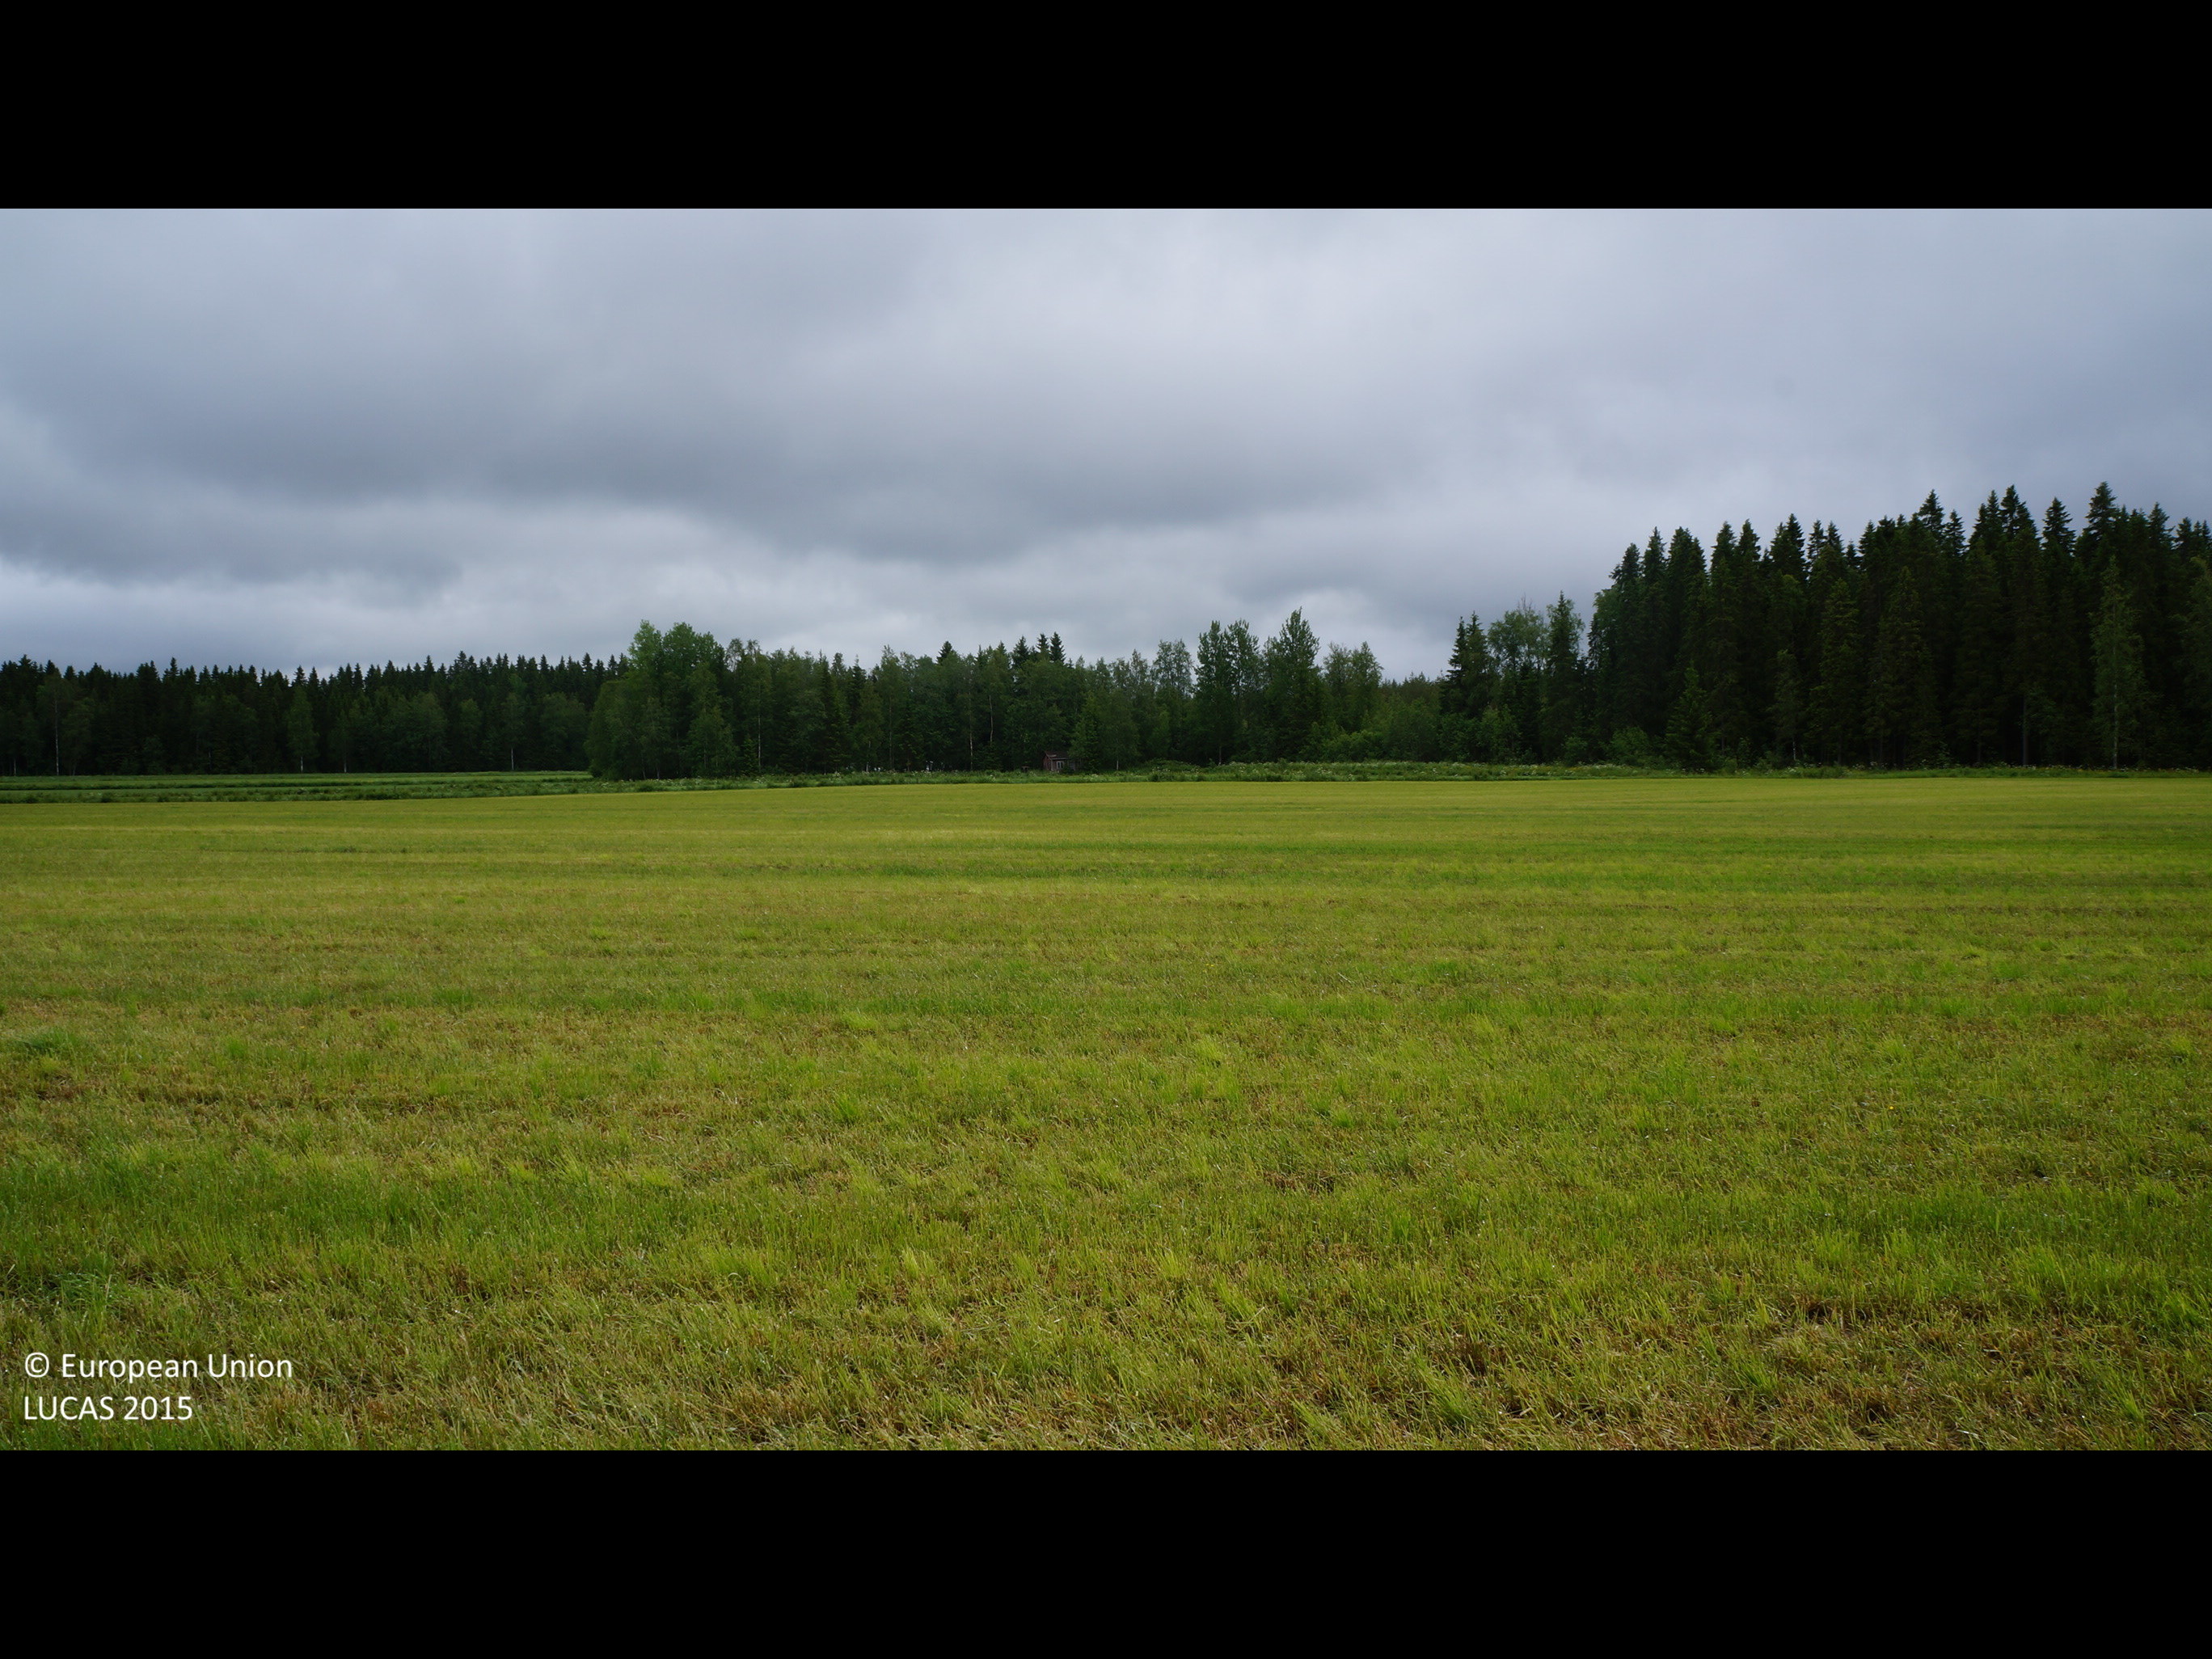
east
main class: Cropland
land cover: Temporary grasslands
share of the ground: > 75 %
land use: Agriculture (excluding fallow land and kitchen gardens)
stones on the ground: < 10 %
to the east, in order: Temporary grasslands; Ditches and canals; Barley; Ditches and canals; Barley; Ditches and canals; Barley; Ditches and canals; Barley; Ditches and canals; Barley; Ditches and canals; Barley
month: June
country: FI
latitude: 63.7161
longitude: 23.1913
